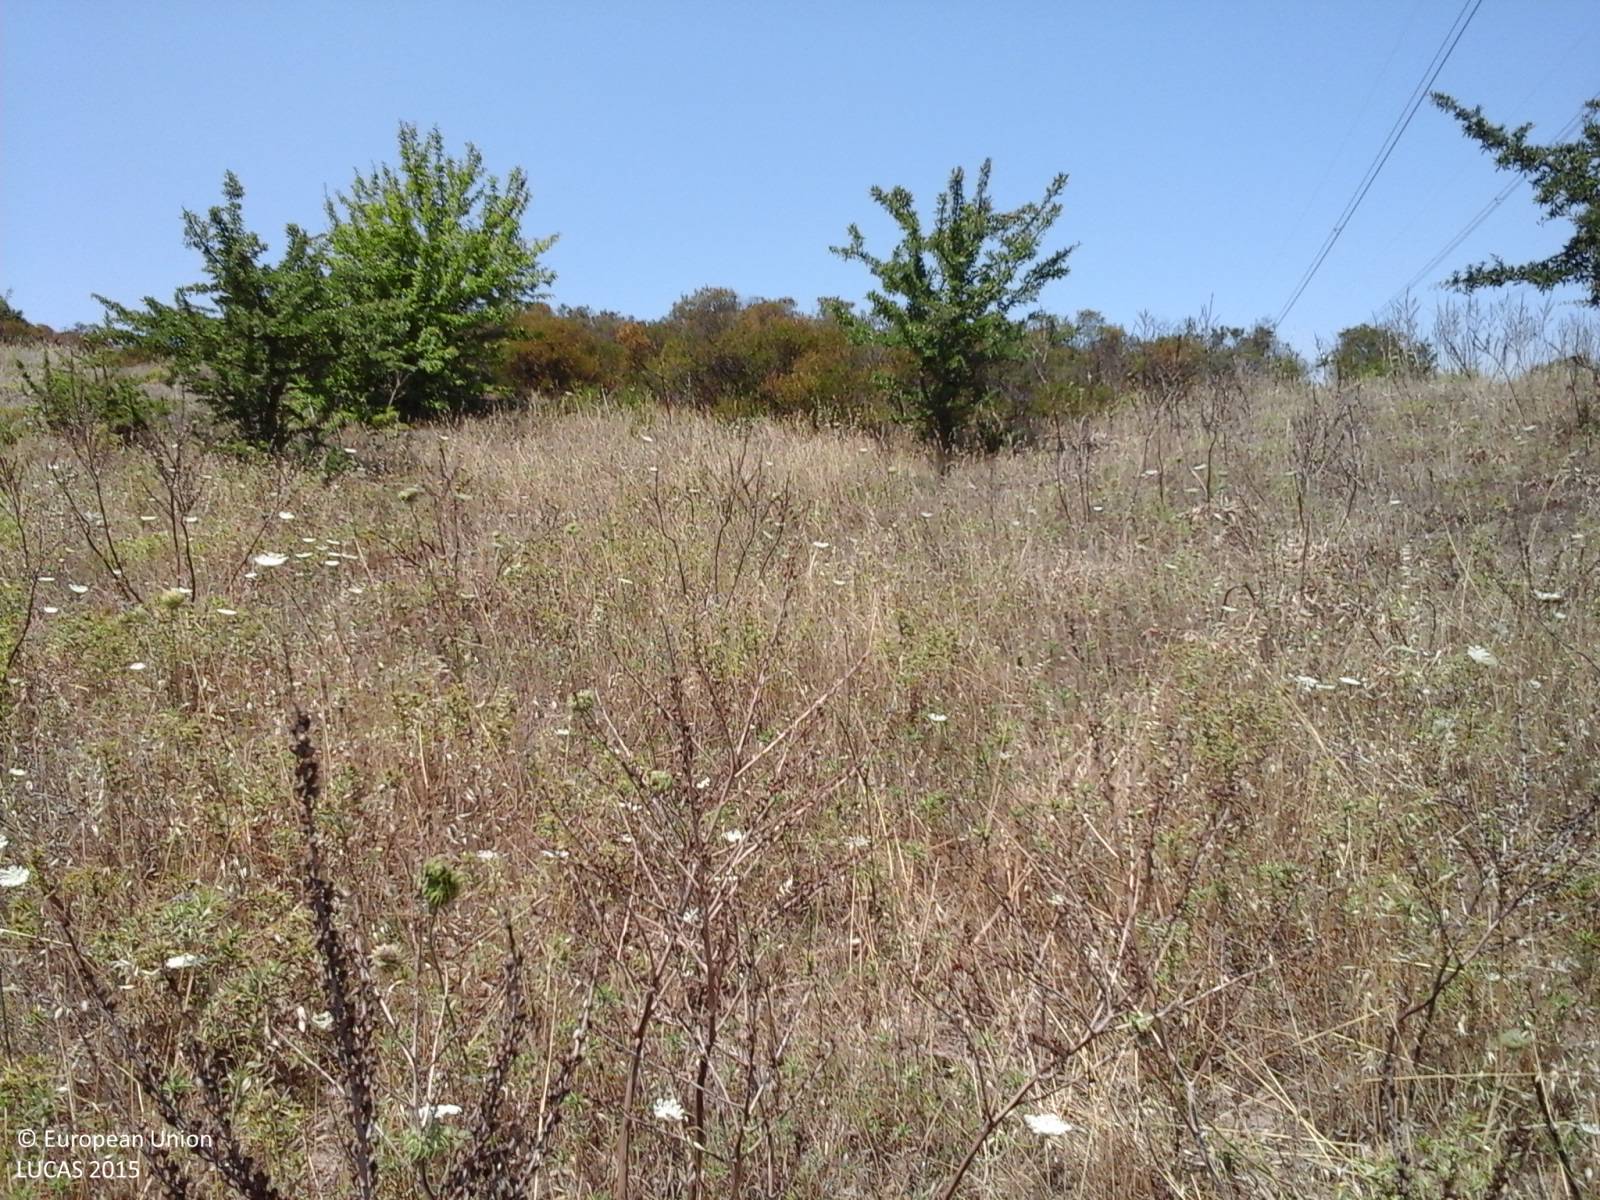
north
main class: Grassland
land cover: Grassland with sparse tree/shrub cover
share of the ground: > 75 %
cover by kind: herbaceous plants 90 %, broadleaved forest trees 5 %, shrubs 5 %
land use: Agriculture (excluding fallow land and kitchen gardens)
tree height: < 5 m
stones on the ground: > 50 %
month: June
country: IT
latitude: 39.8803
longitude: 8.8488
